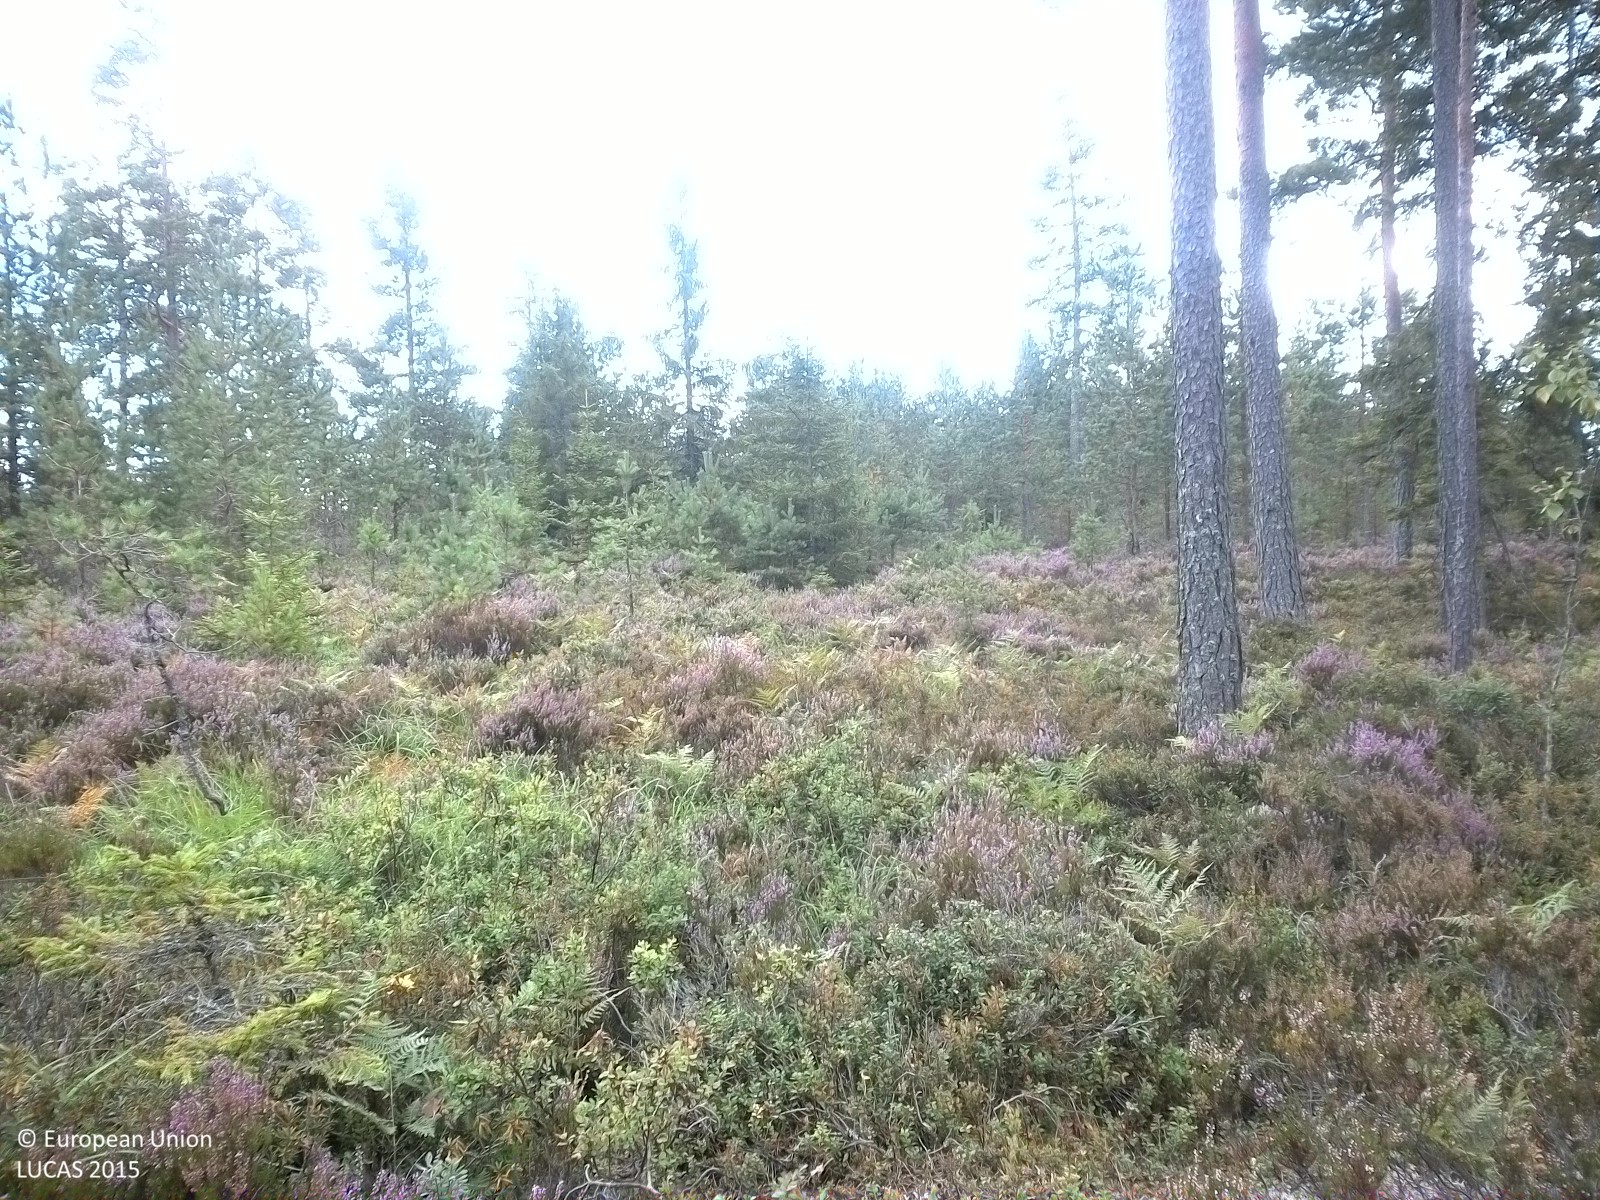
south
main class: Woodland
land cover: Pine dominated coniferous woodland
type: boreal forest
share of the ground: 25 - 50 %
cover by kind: shrubs 50 %, coniferous forest trees 25 %, lichens and mosses 15 %, herbaceous plants 10 %
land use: Forestry
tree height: > 5 m
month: August
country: SE
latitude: 58.9862
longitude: 15.6132
